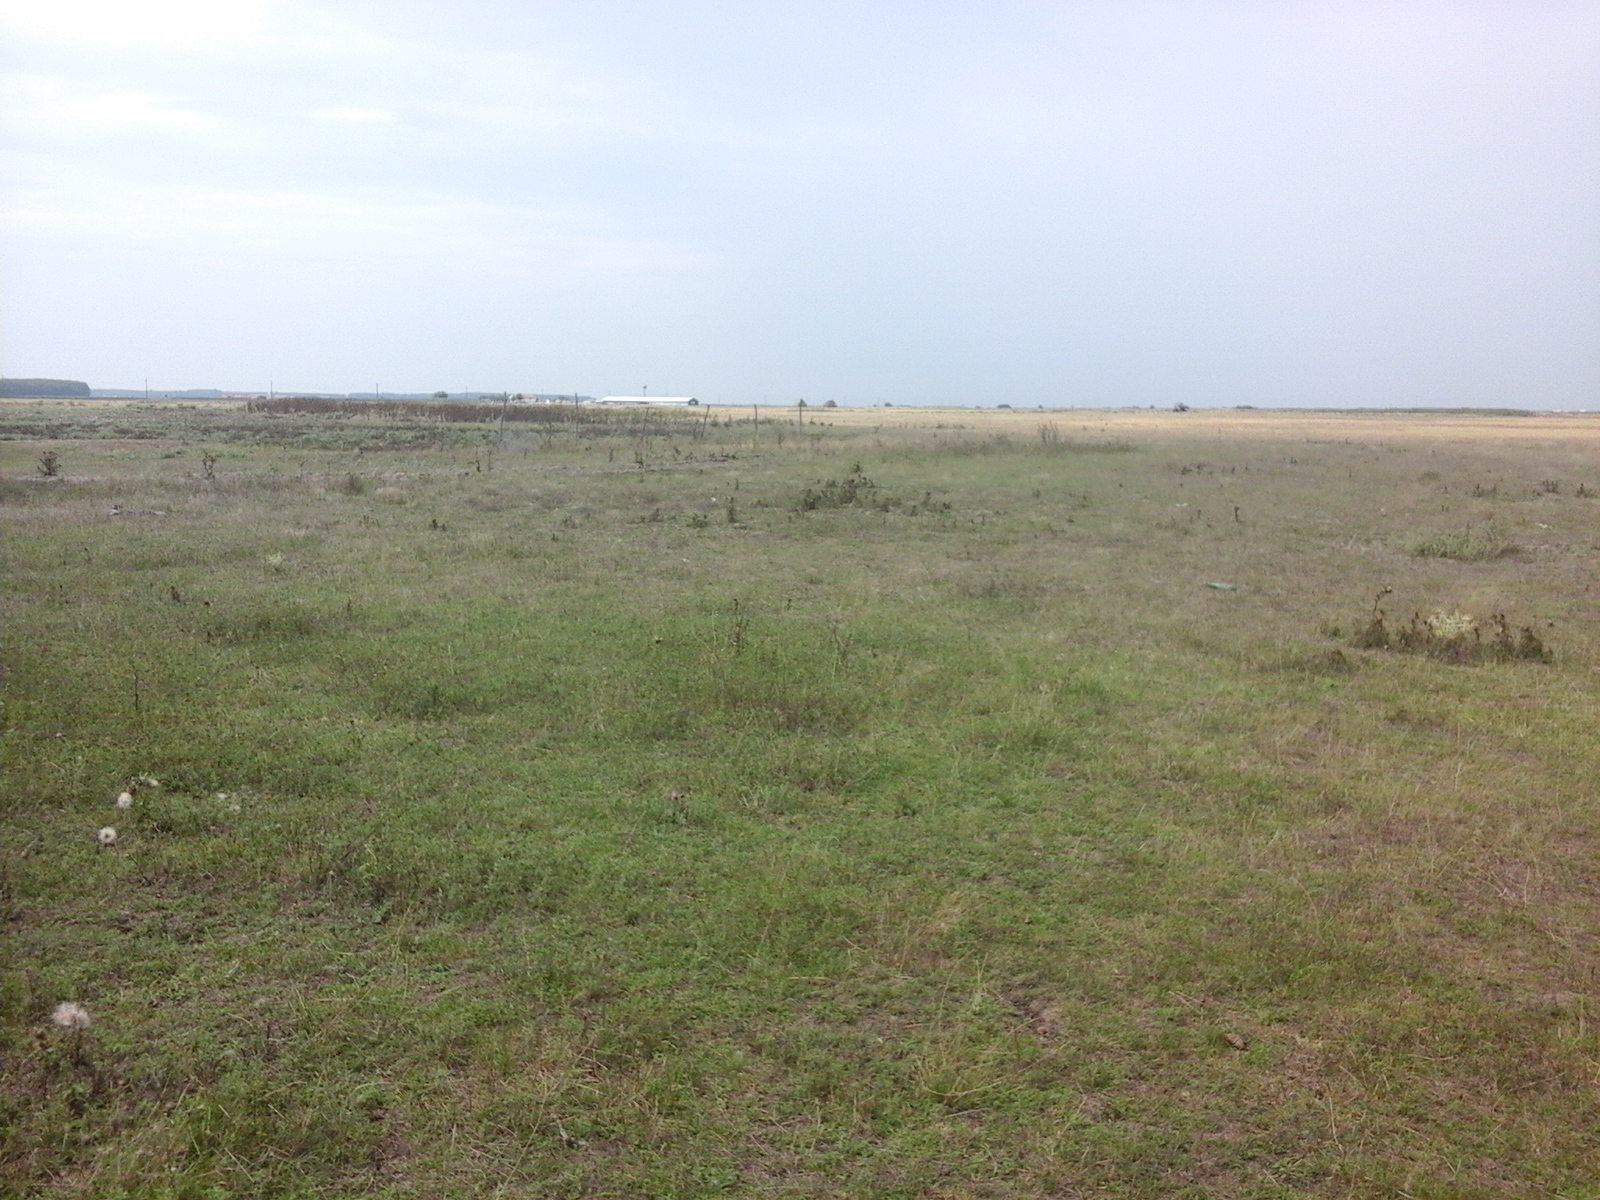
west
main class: Grassland
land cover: Grassland without tree/shrub cover
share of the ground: > 75 %
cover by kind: herbaceous plants 100 %
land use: Agriculture (excluding fallow land and kitchen gardens)
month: August
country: RO
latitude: 46.5824
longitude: 21.5093
